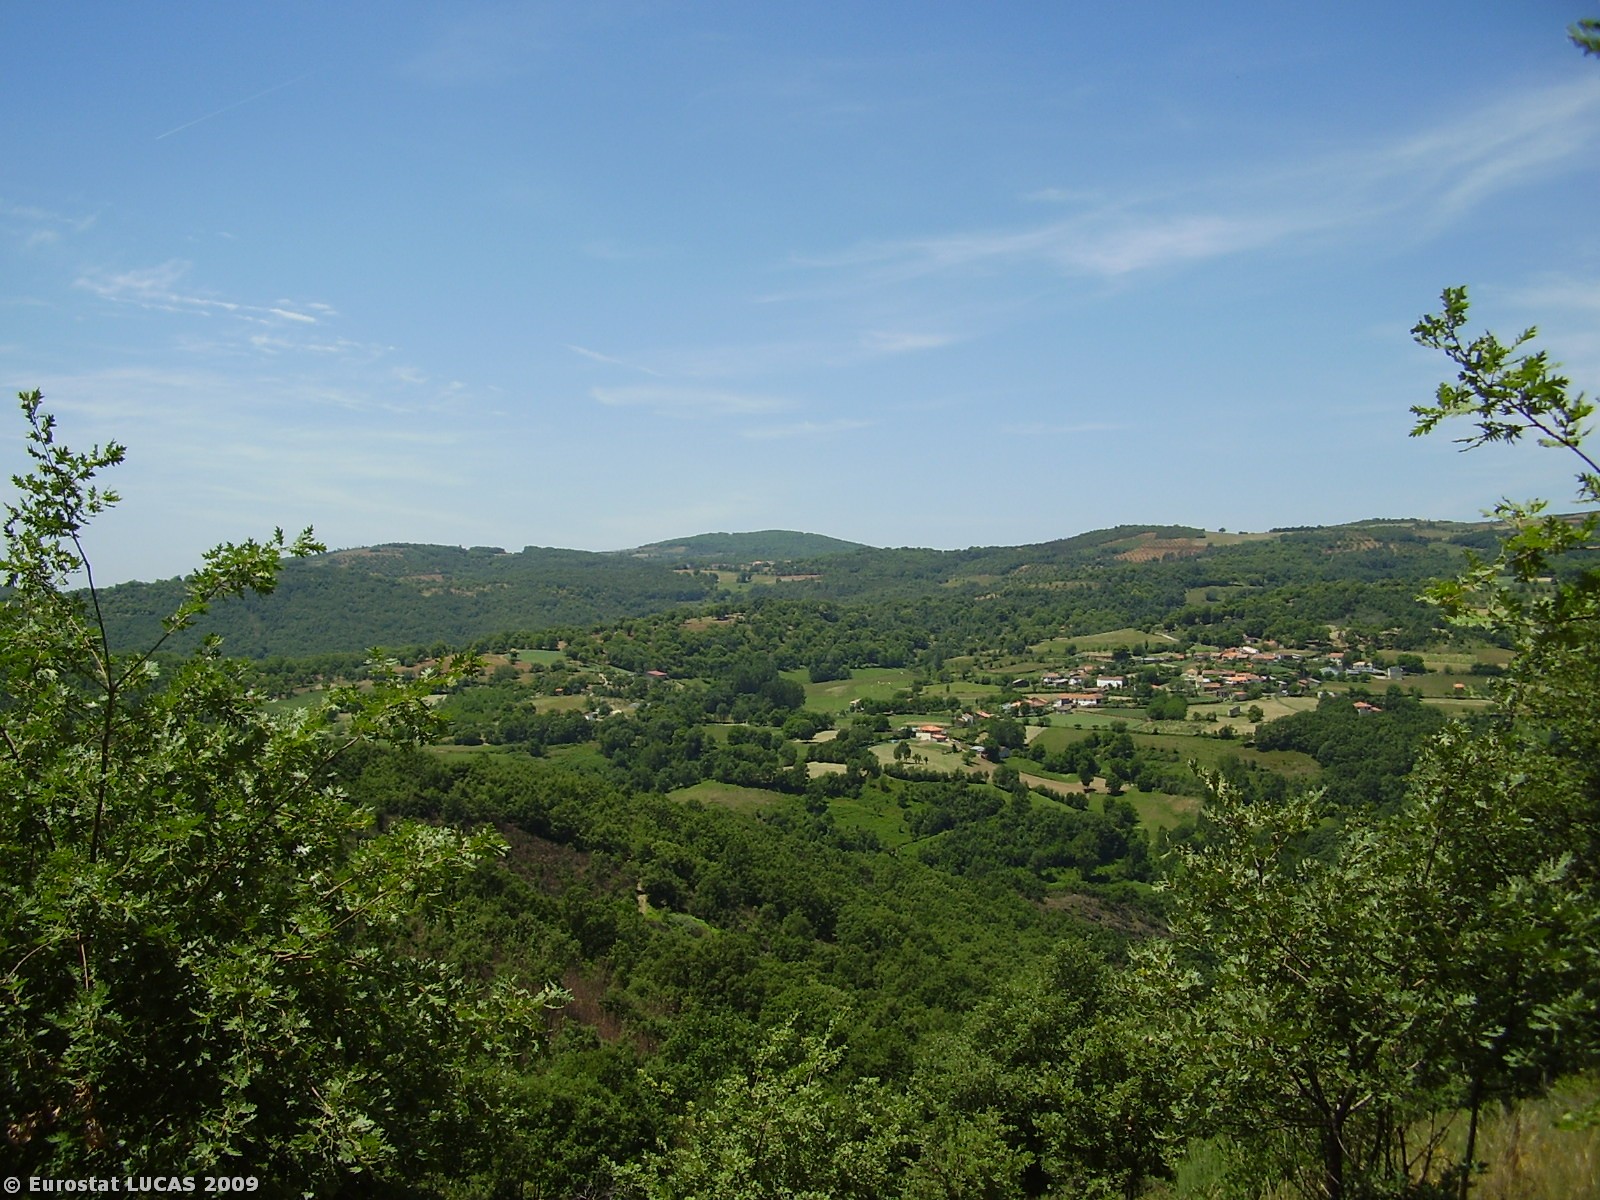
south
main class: Shrubland
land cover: Shrubland with sparse tree cover
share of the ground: 10 - 25 %
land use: Nature reserves
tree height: > 5 m
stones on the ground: 25 - 50 %
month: June
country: PT
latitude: 41.8622
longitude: -6.9234
